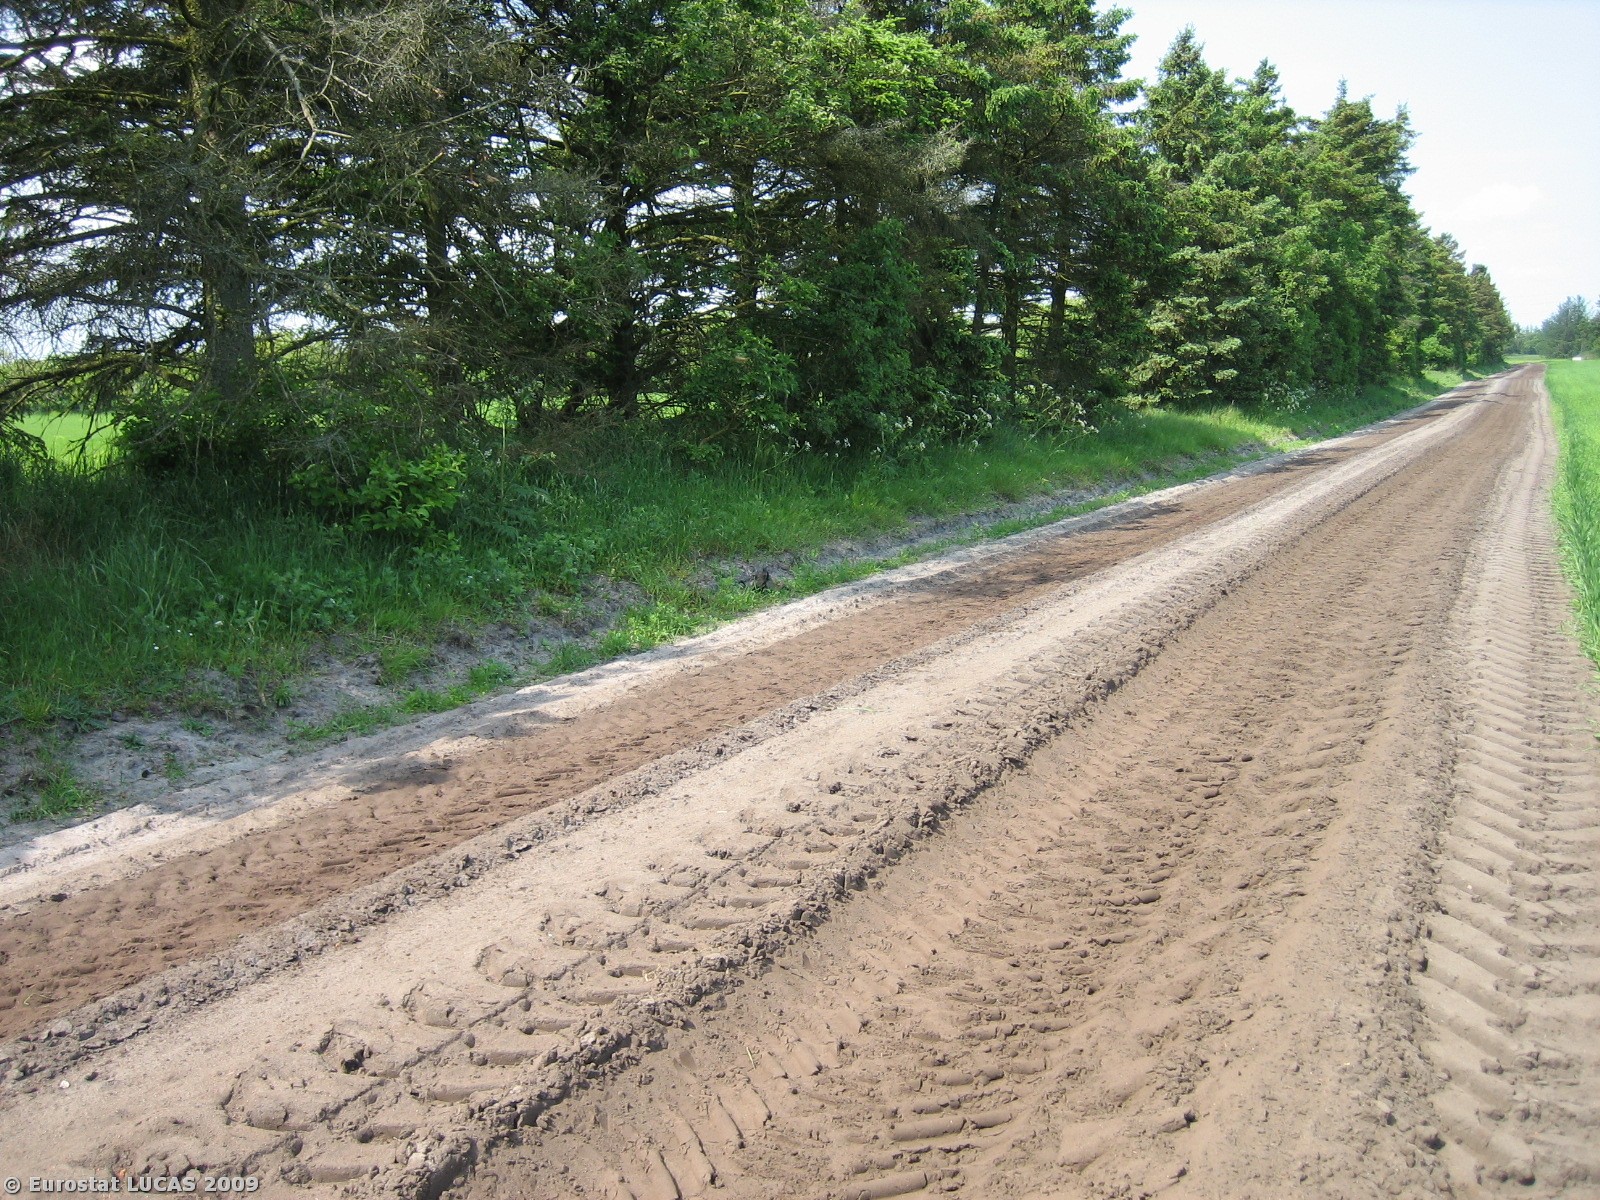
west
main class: Cropland
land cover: Barley
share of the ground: > 75 %
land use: Agriculture (excluding fallow land and kitchen gardens)
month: May
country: DK
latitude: 56.1138
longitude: 9.2771
